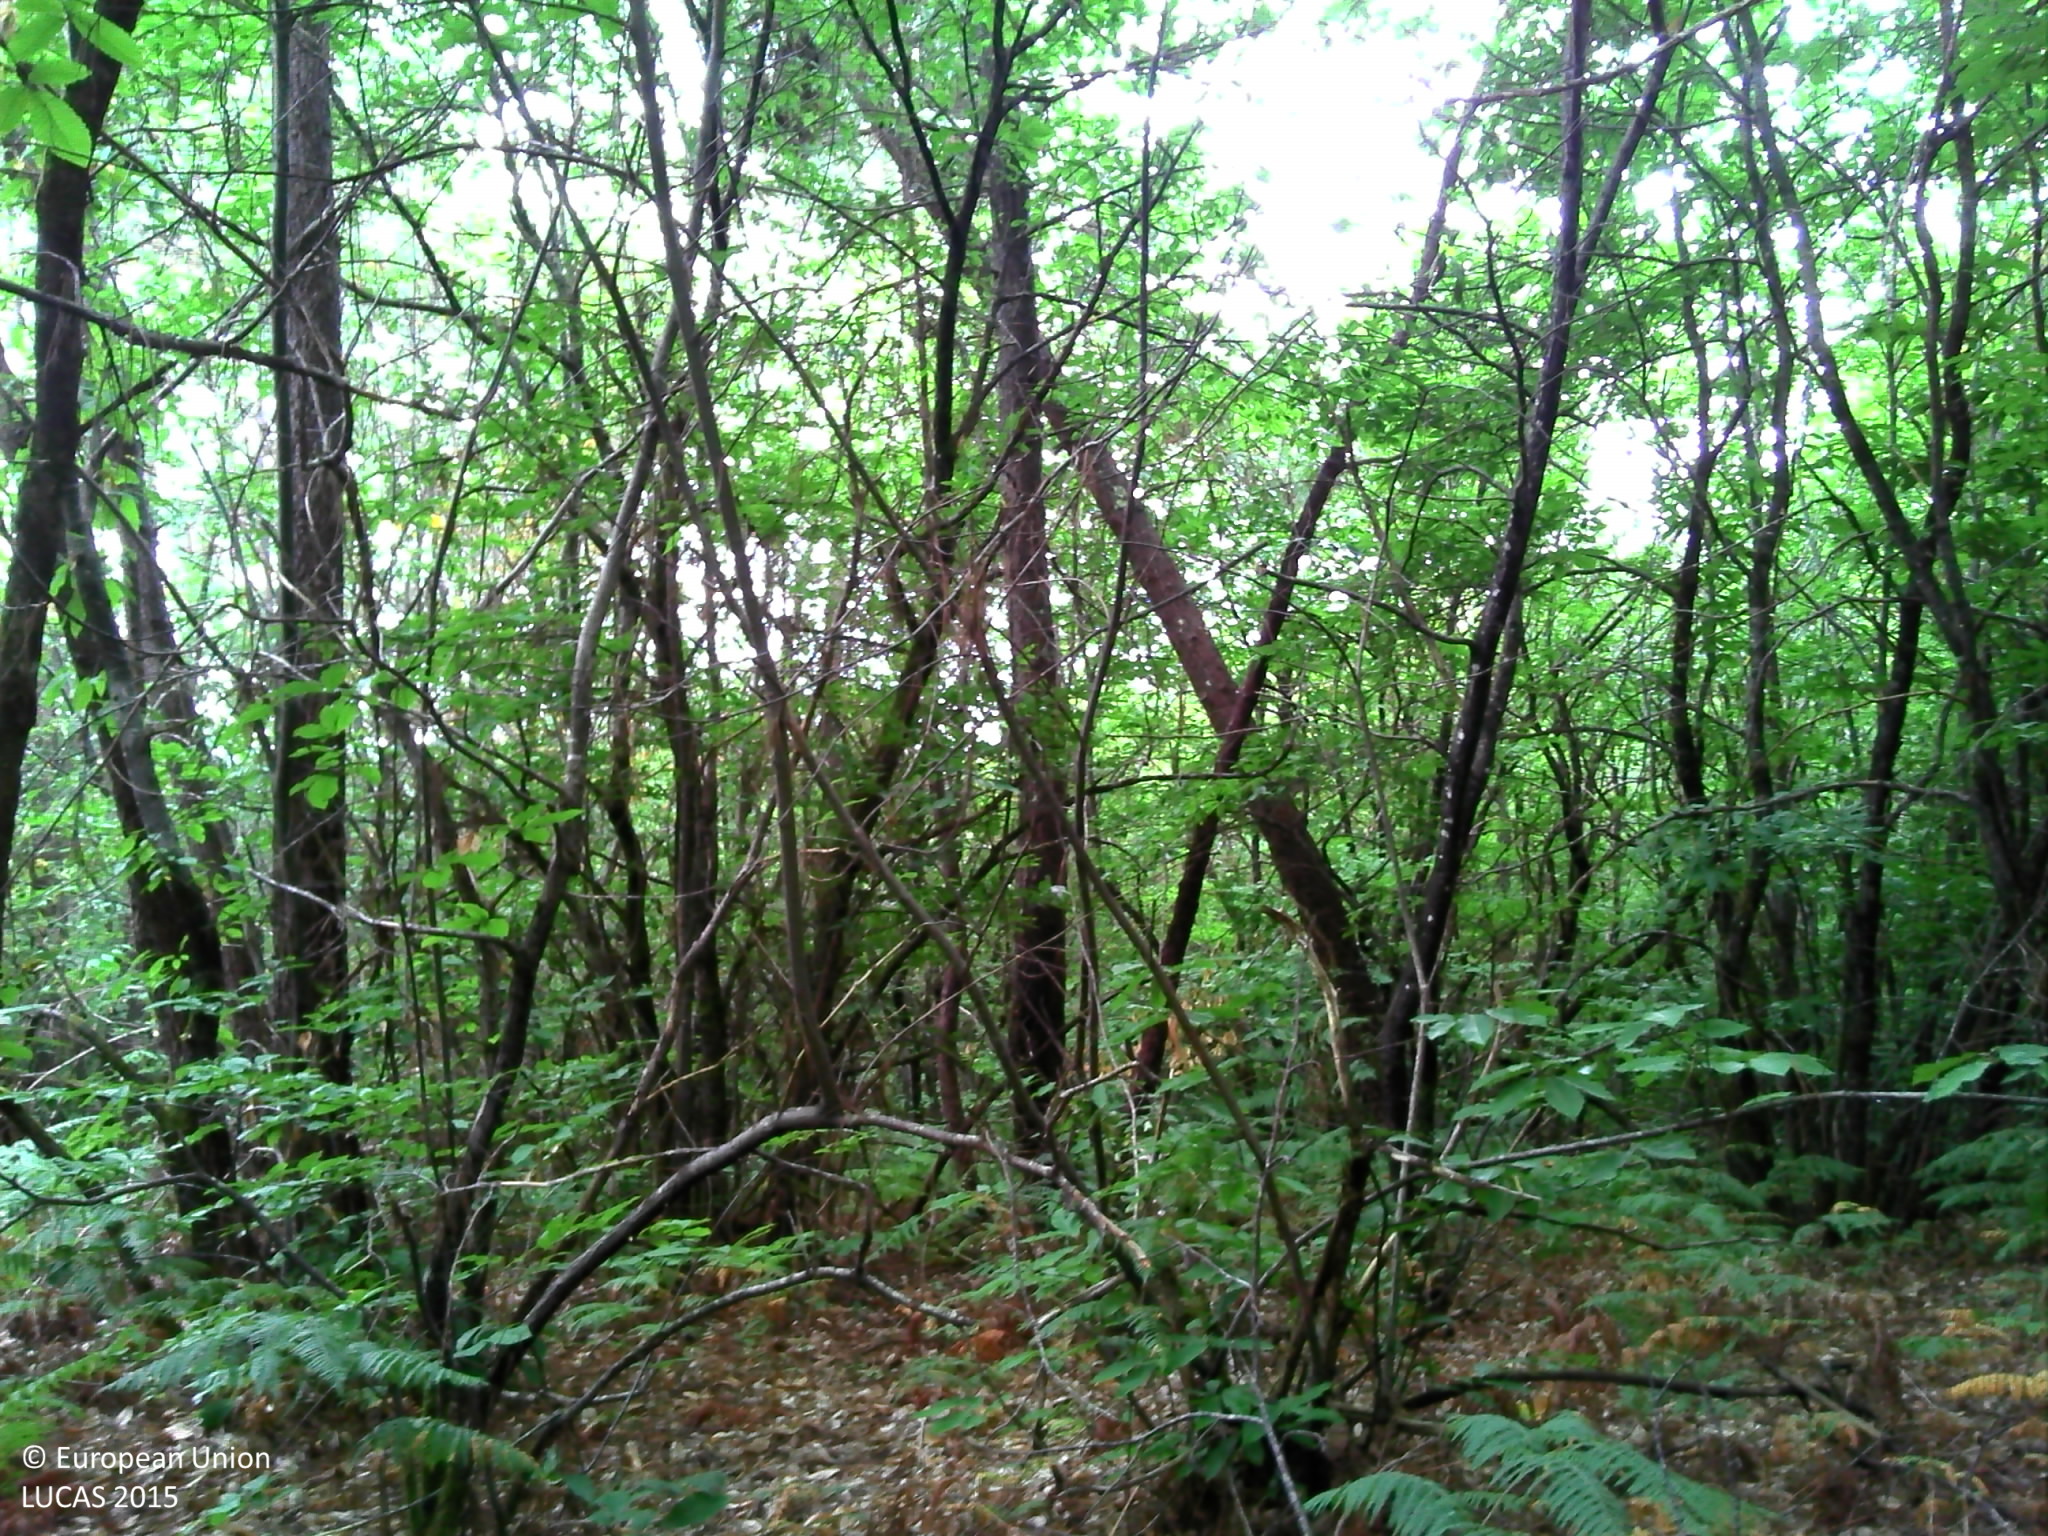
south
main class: Woodland
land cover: Pine dominated mixed woodland
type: thermophilous deciduous forest
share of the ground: > 75 %
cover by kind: broadleaved forest trees 55 %, coniferous forest trees 20 %, herbaceous plants 10 %, lichens and mosses 10 %, shrubs 5 %
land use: Forestry
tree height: > 5 m
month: July
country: FR
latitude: 44.9859
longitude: 0.9243
